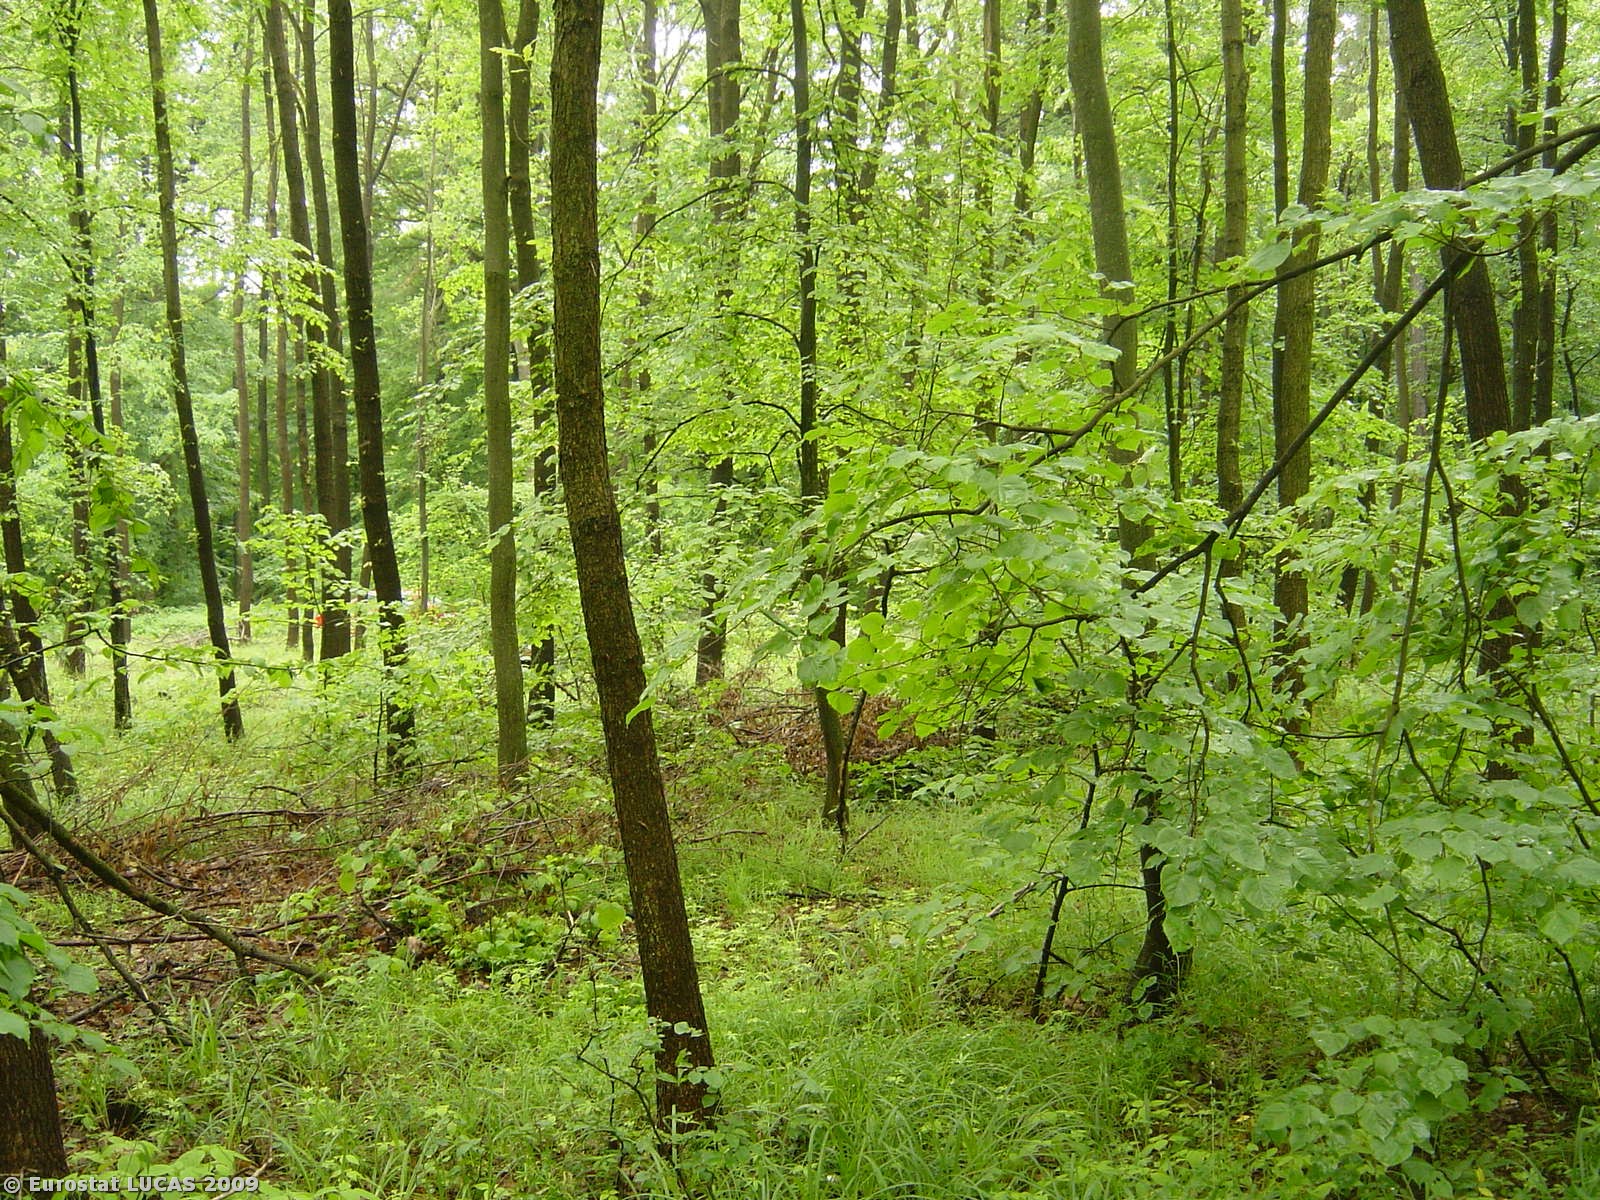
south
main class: Woodland
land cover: Broadleaved woodland
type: mesophytic deciduous forest
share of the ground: > 75 %
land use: Forestry
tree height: > 5 m
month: May
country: CZ
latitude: 49.2238
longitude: 17.0808
